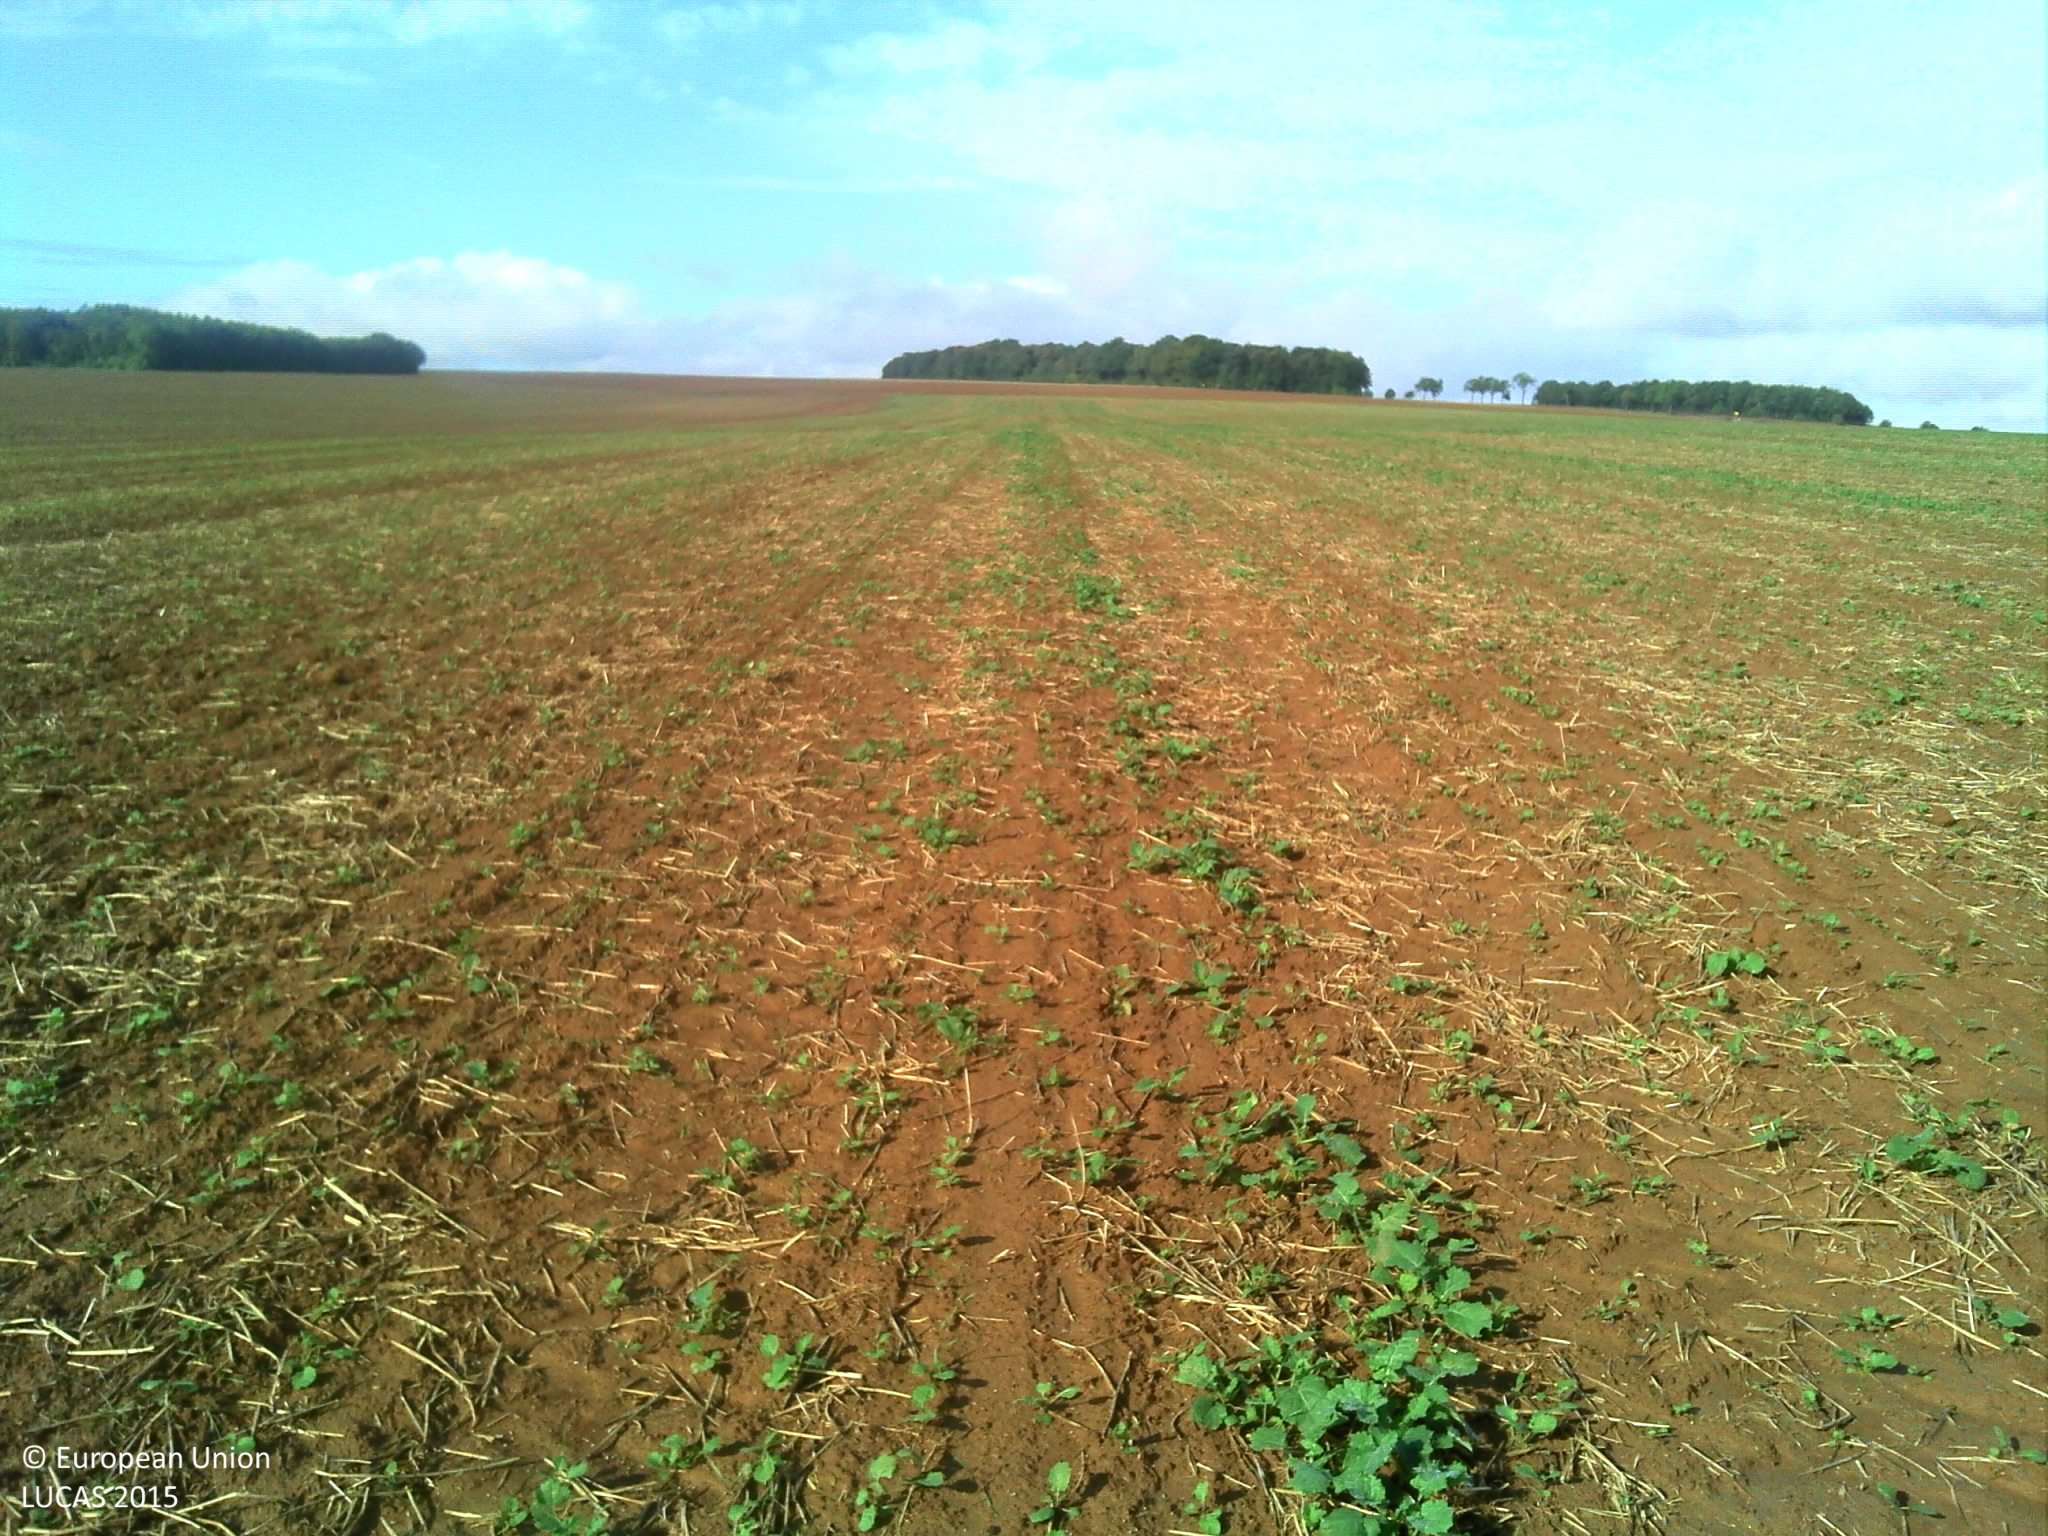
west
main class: Cropland
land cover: Other fibre and oleaginous crops
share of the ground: < 10 %
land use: Agriculture (excluding fallow land and kitchen gardens)
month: September
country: FR
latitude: 48.8179
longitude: 6.0093
